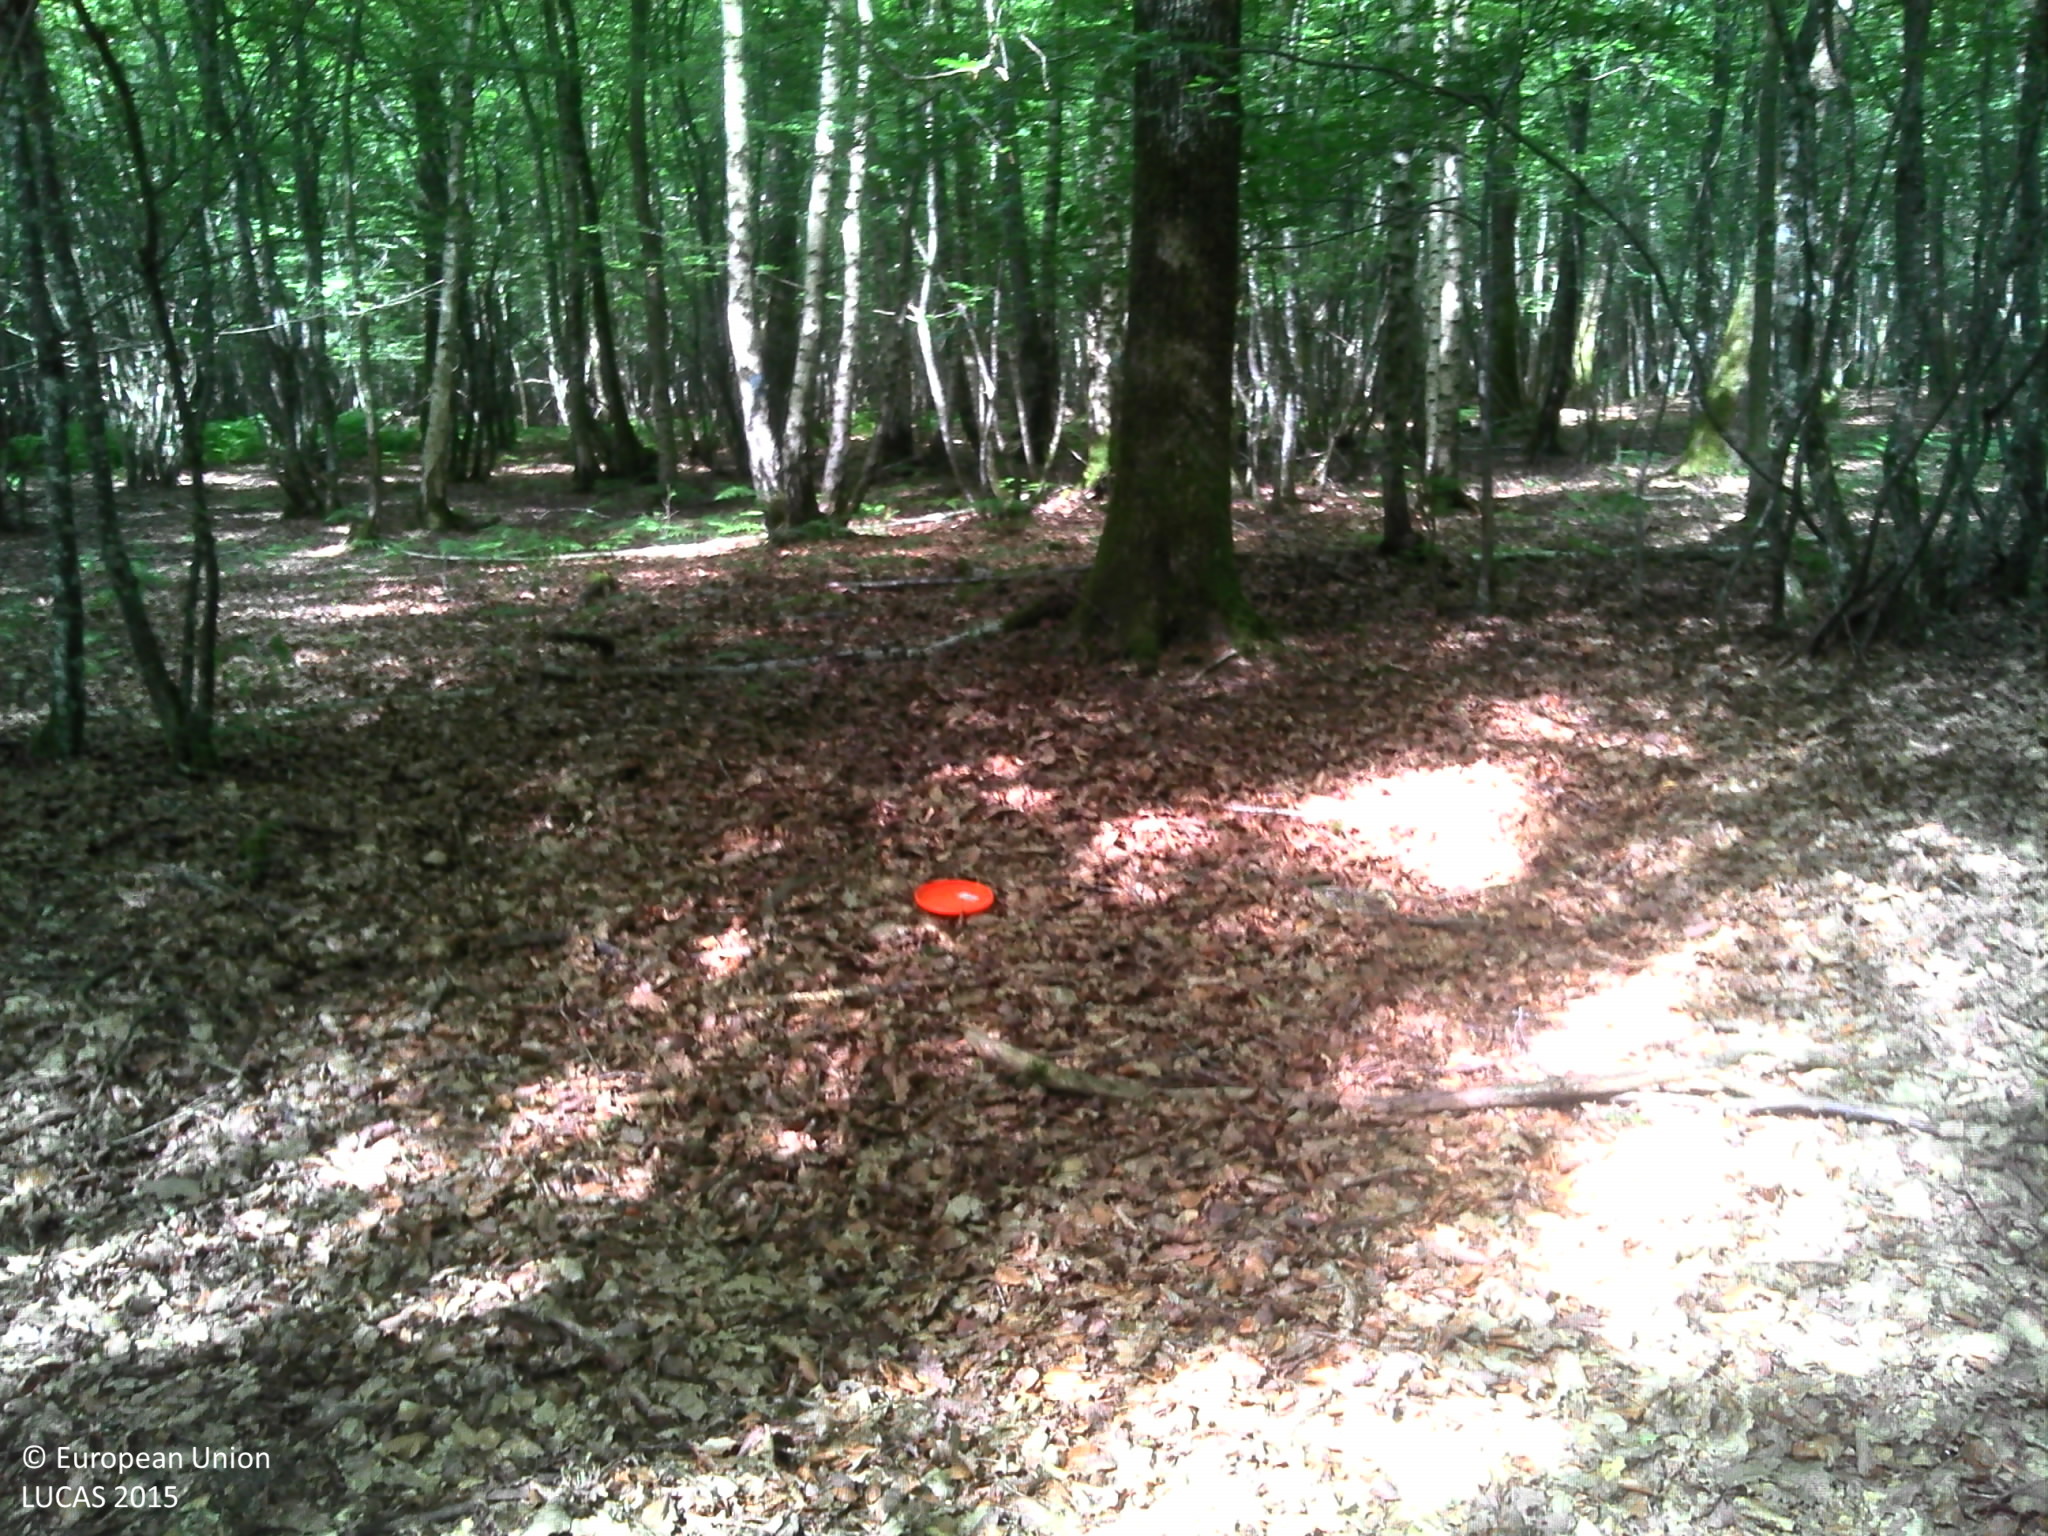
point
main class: Woodland
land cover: Broadleaved woodland
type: mesophytic deciduous forest
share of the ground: > 75 %
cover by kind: broadleaved forest trees 90 %, herbaceous plants 5 %, lichens and mosses 5 %
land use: Forestry
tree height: > 5 m
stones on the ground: < 10 %
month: June
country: FR
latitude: 48.0686
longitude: 3.5129
